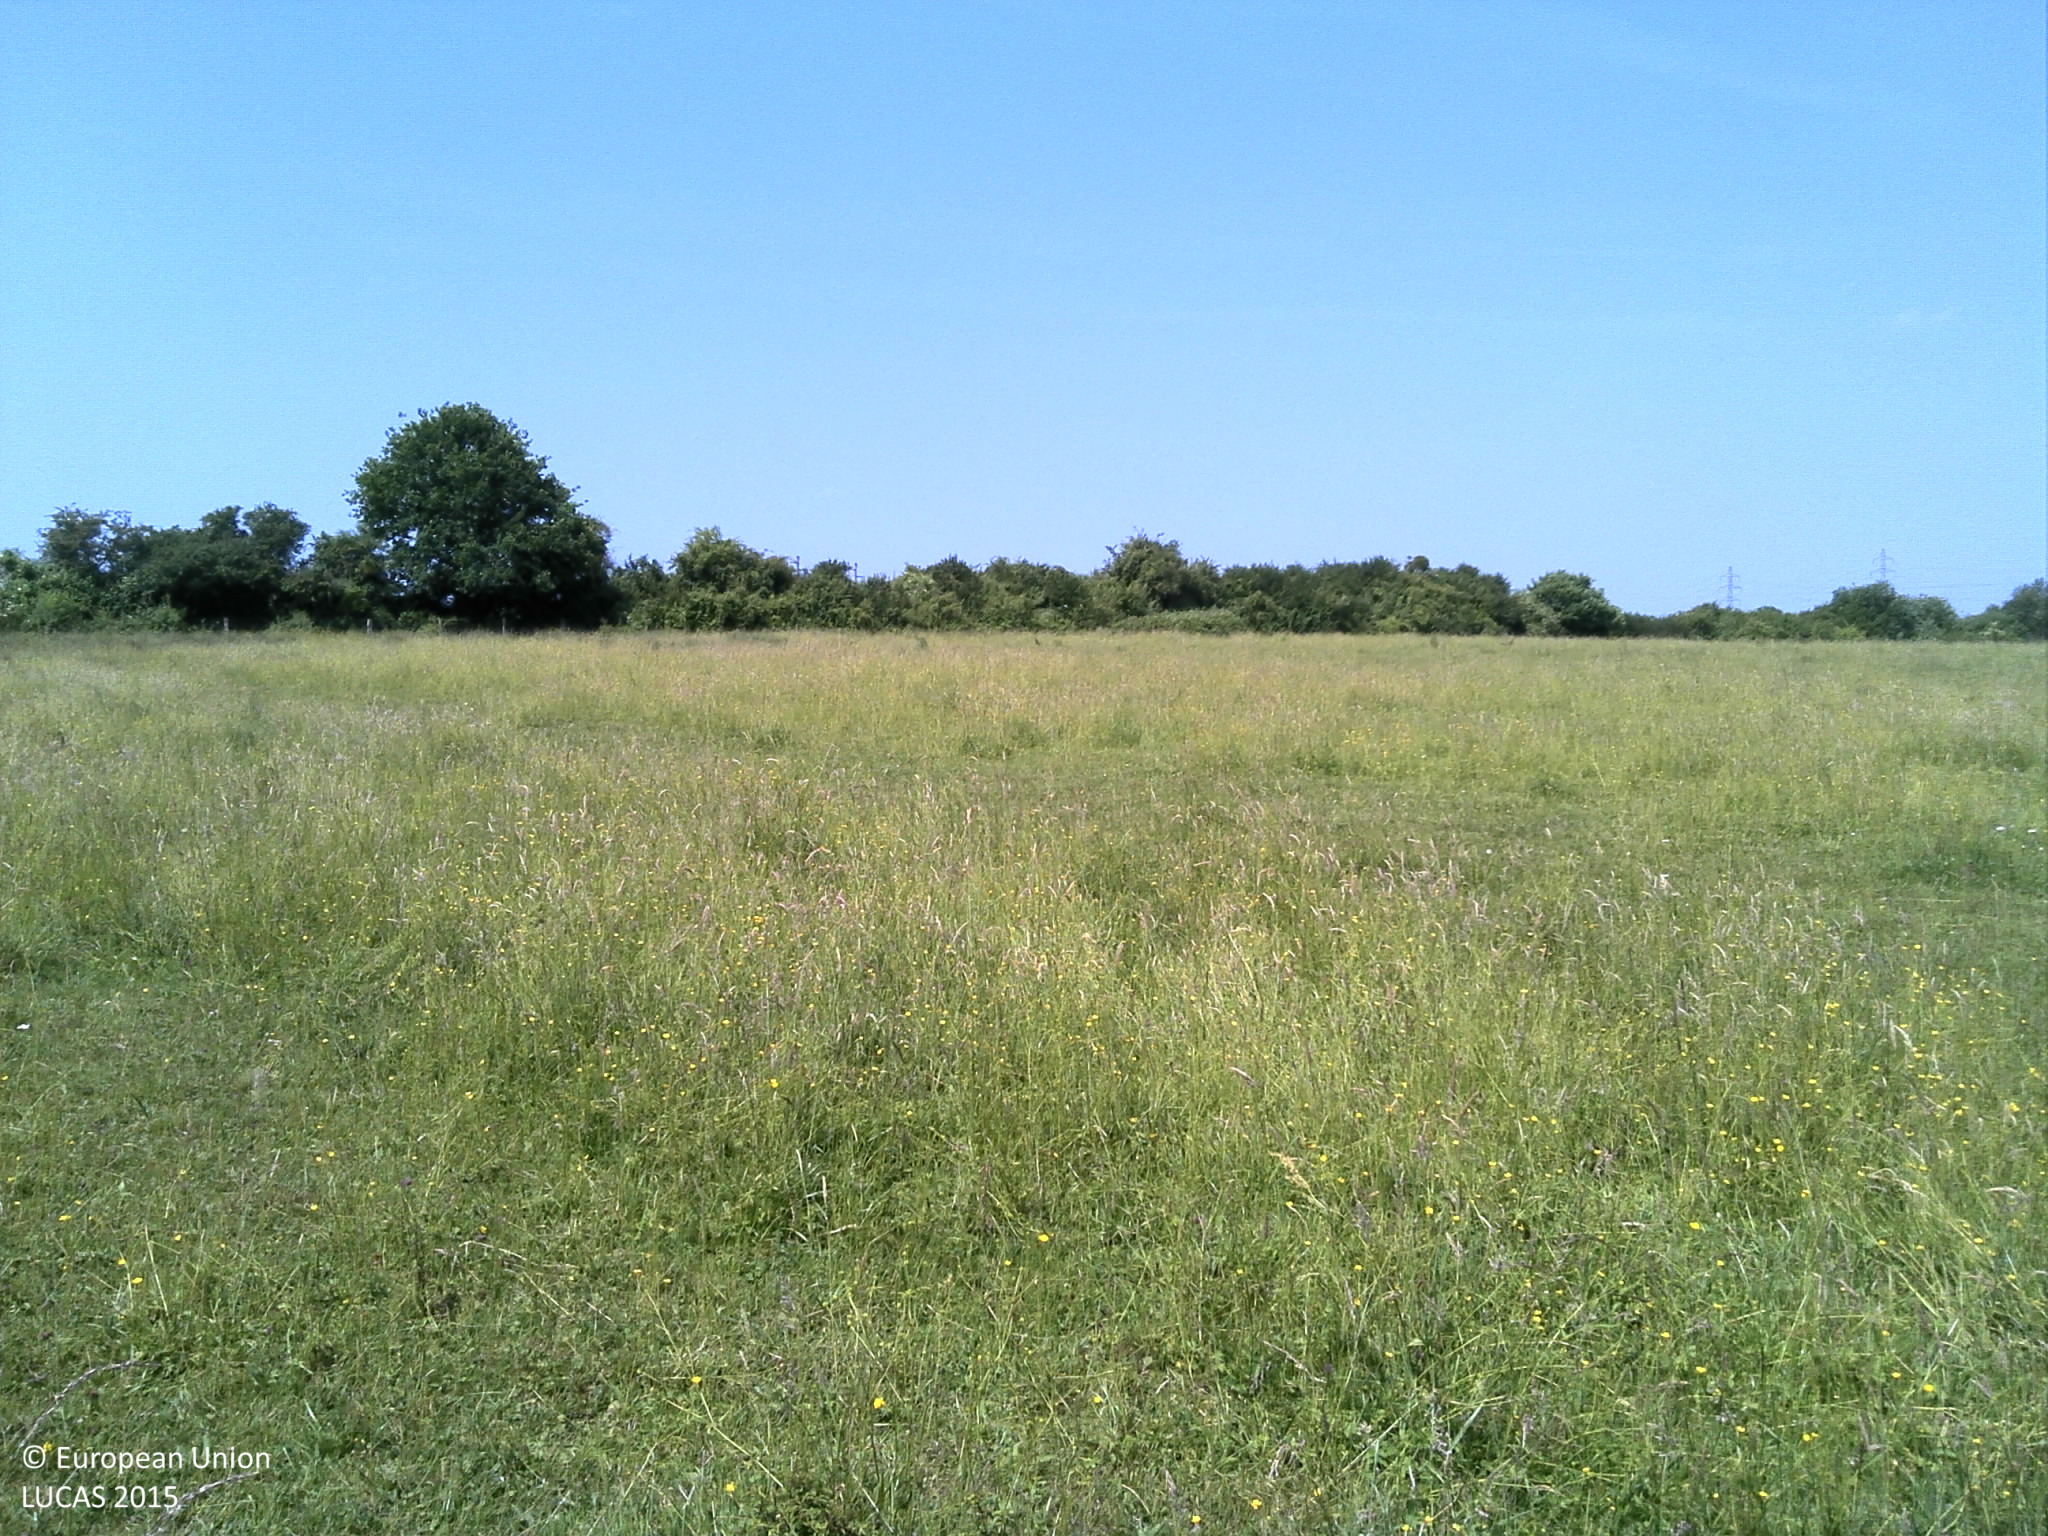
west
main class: Grassland
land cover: Grassland without tree/shrub cover
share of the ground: > 75 %
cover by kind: herbaceous plants 100 %
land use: Agriculture (excluding fallow land and kitchen gardens)
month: June
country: FR
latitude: 49.0590
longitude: 6.2090
